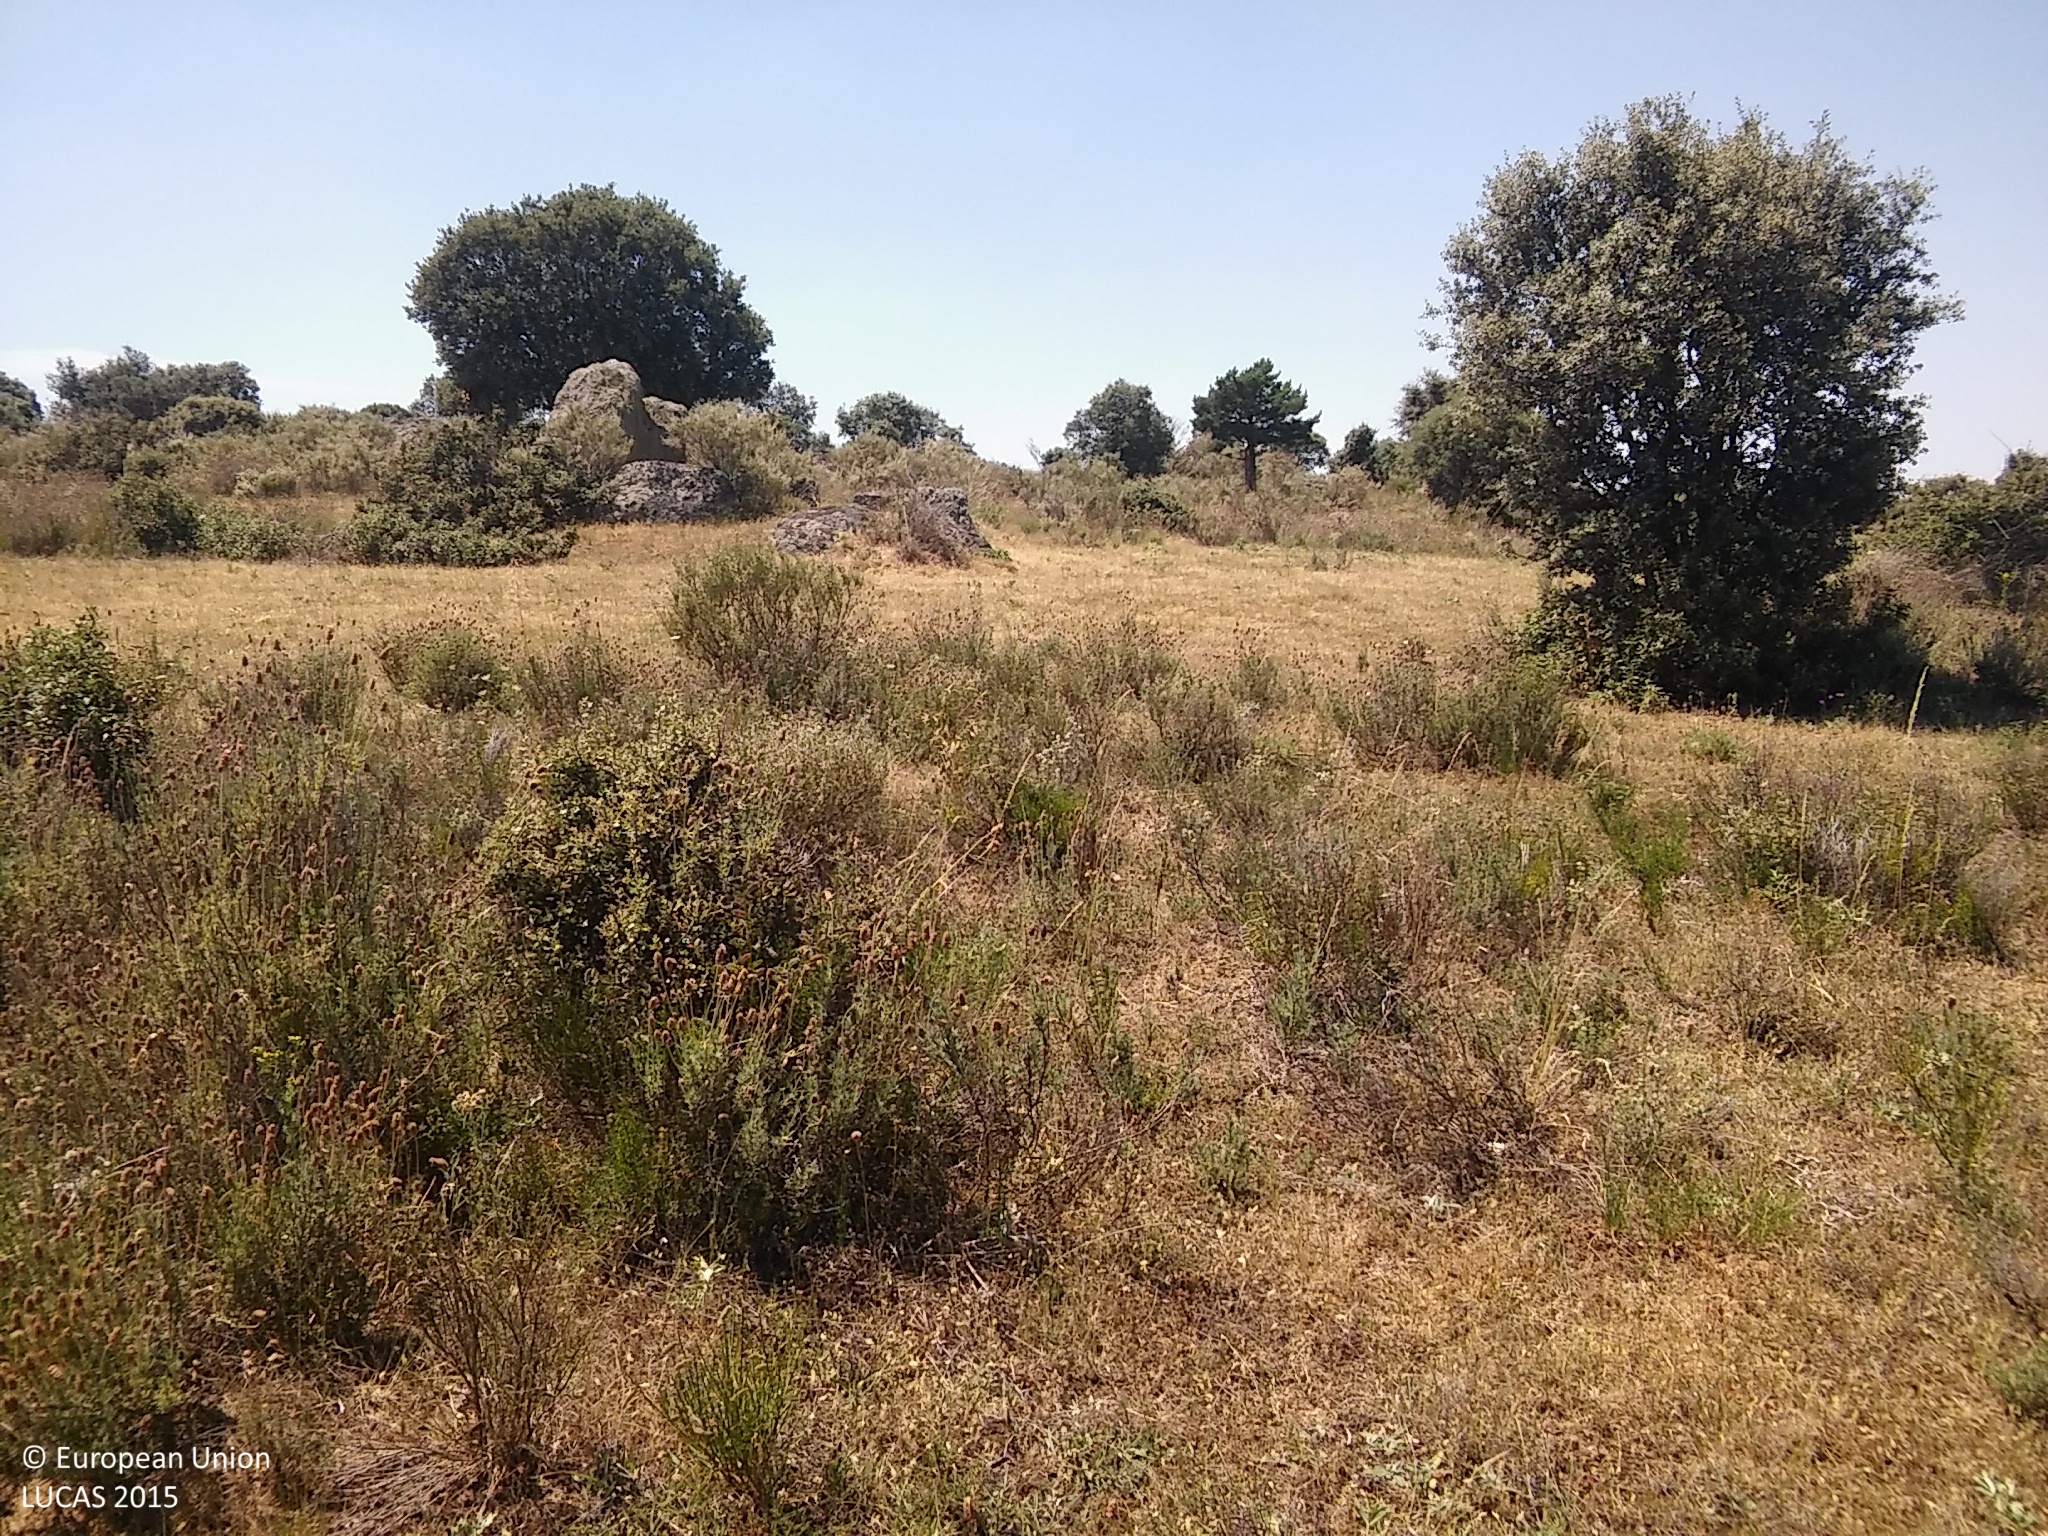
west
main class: Shrubland
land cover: Shrubland with sparse tree cover
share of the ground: 50 - 75 %
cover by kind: shrubs 55 %, herbaceous plants 40 %, coniferous forest trees 5 %
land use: Agriculture (excluding fallow land and kitchen gardens)
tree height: < 5 m
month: June
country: ES
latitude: 41.1050
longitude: -3.8973
